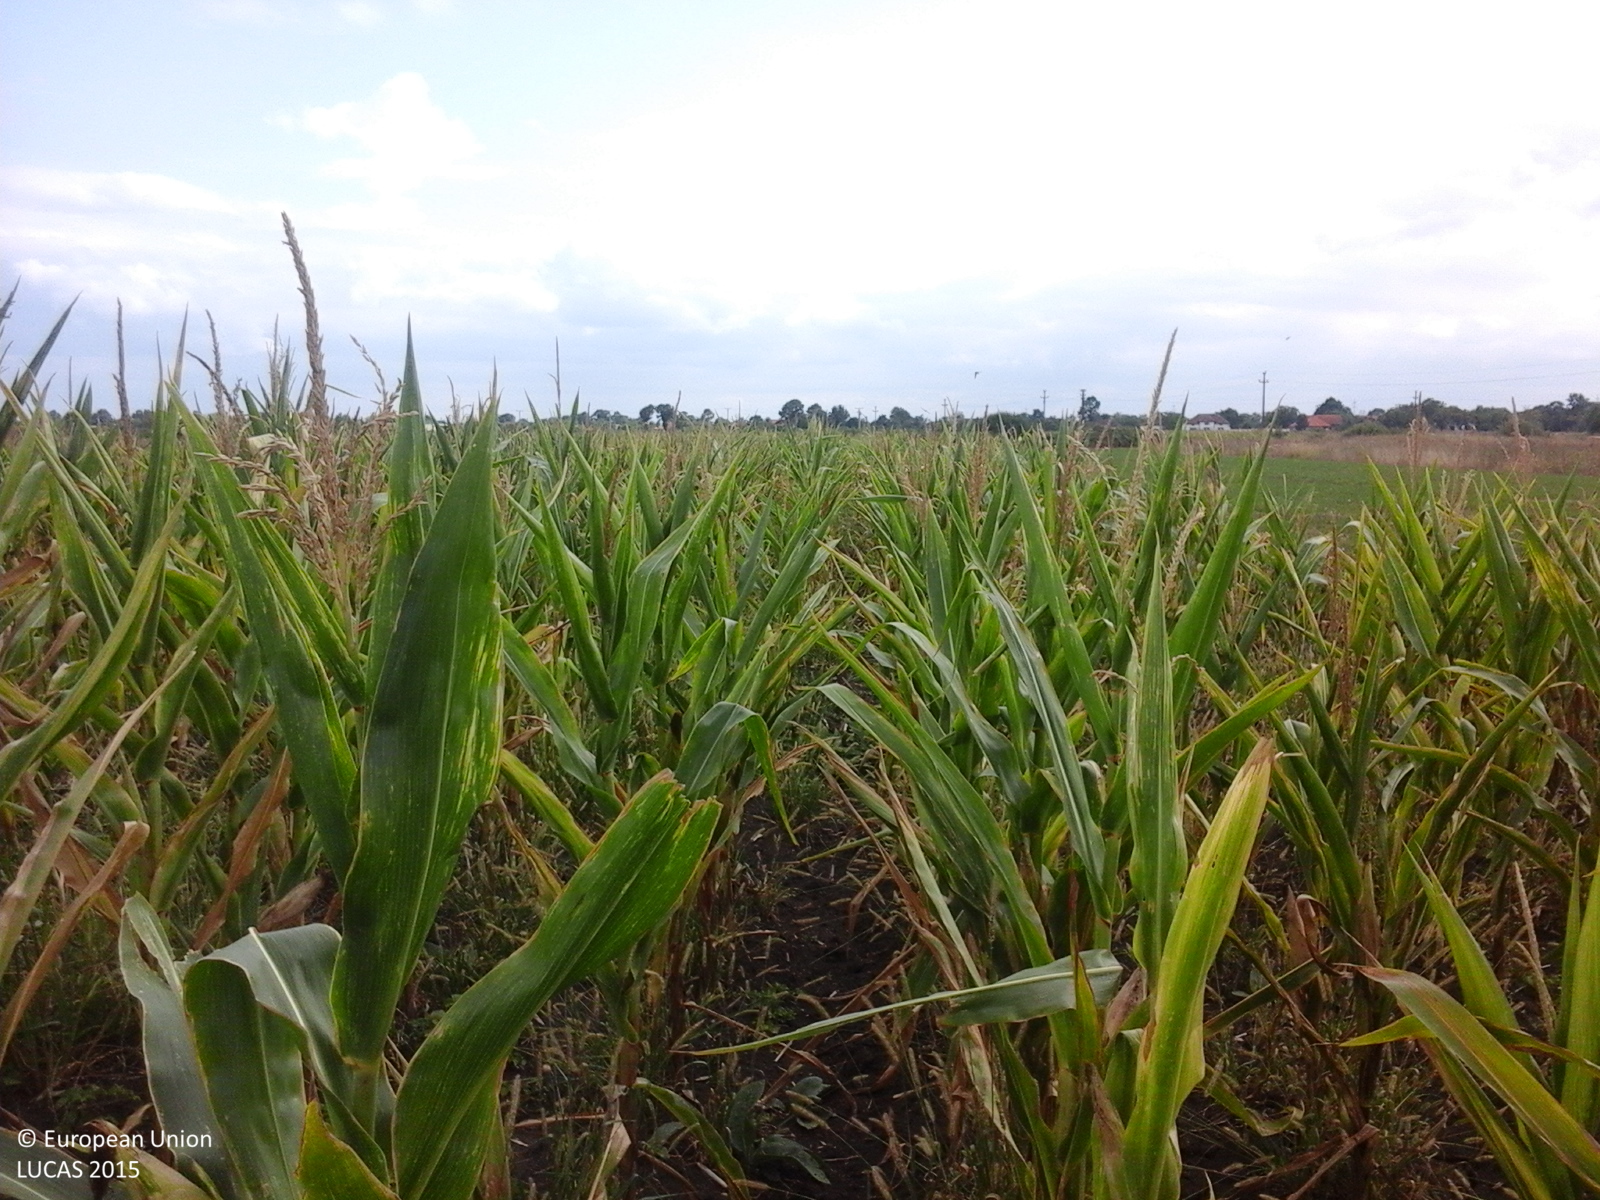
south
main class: Cropland
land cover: Maize
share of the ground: > 75 %
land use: Agriculture (excluding fallow land and kitchen gardens)
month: August
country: RO
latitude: 45.5911
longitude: 21.4275
